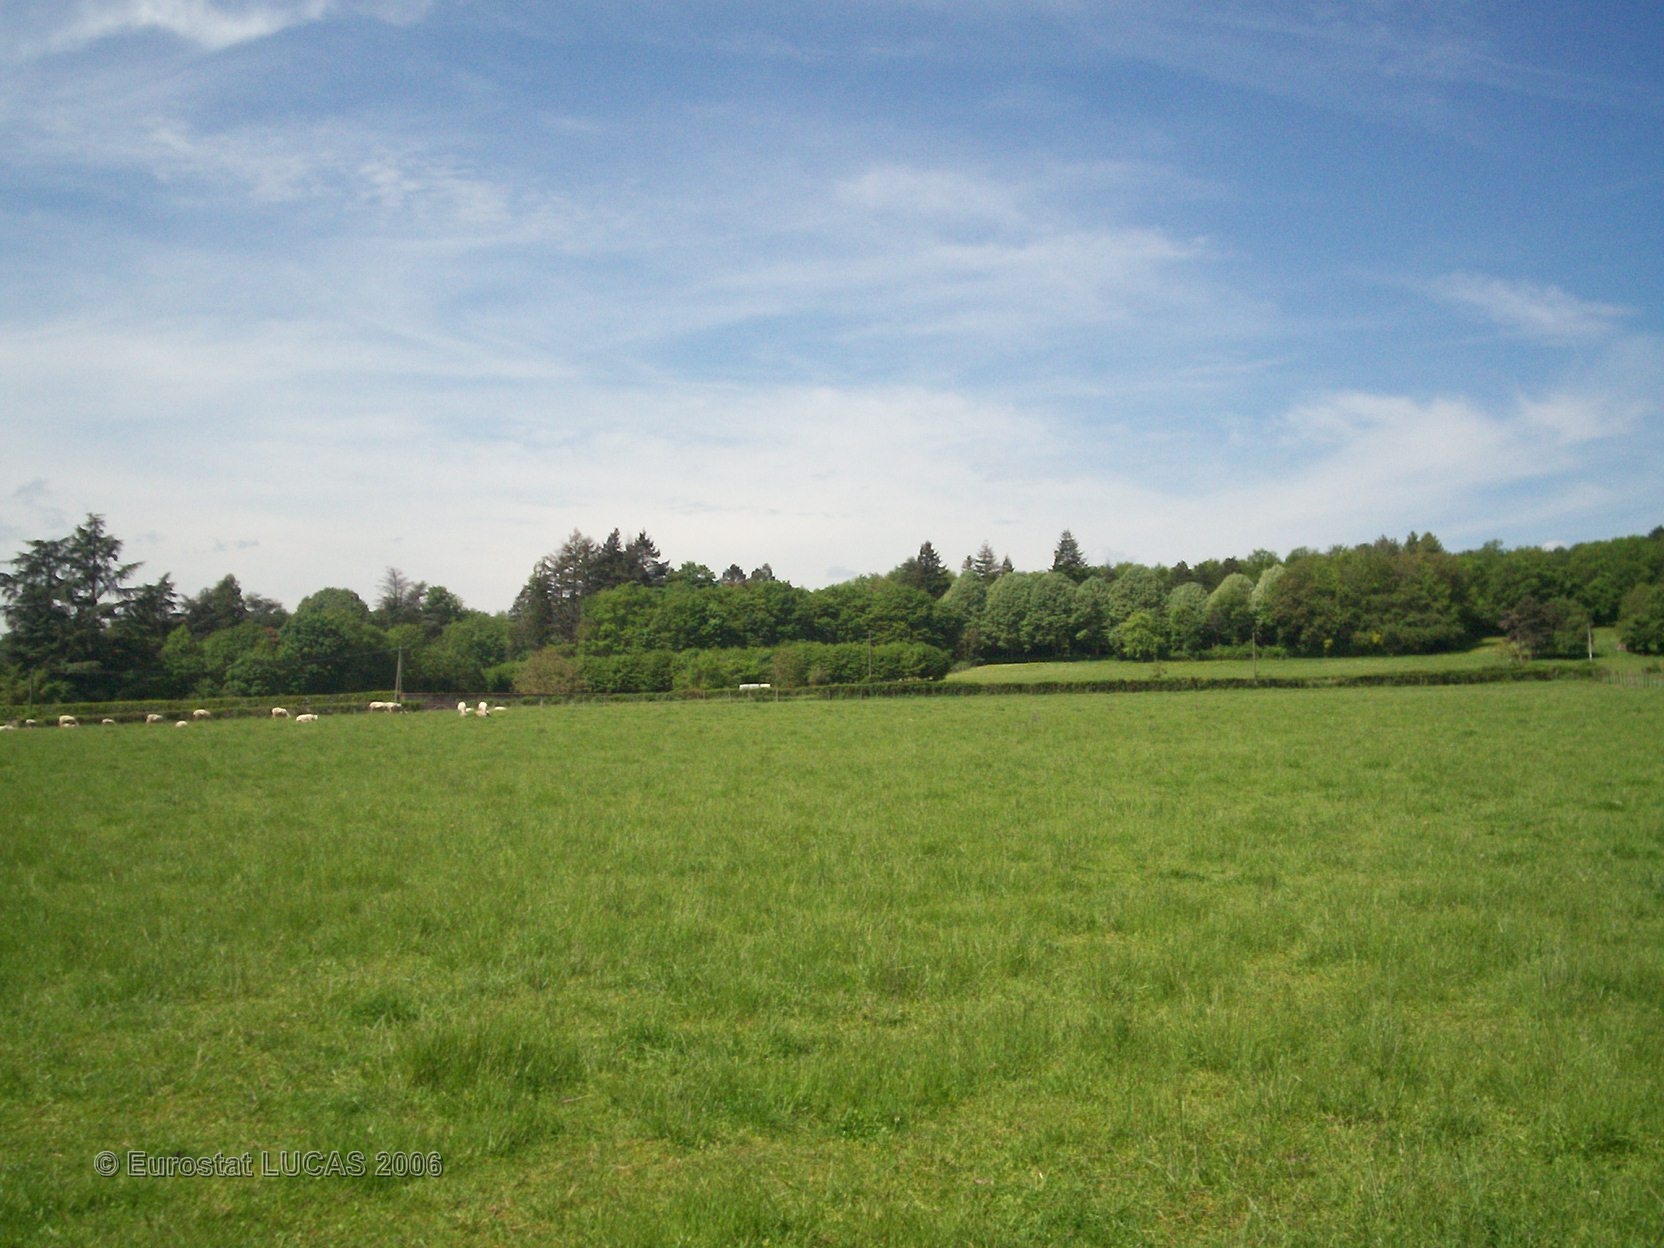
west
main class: Grassland
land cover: Grassland without tree/shrub cover
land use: Agriculture (excluding fallow land and kitchen gardens)
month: May
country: FR
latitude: 46.5829
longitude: 4.7424
